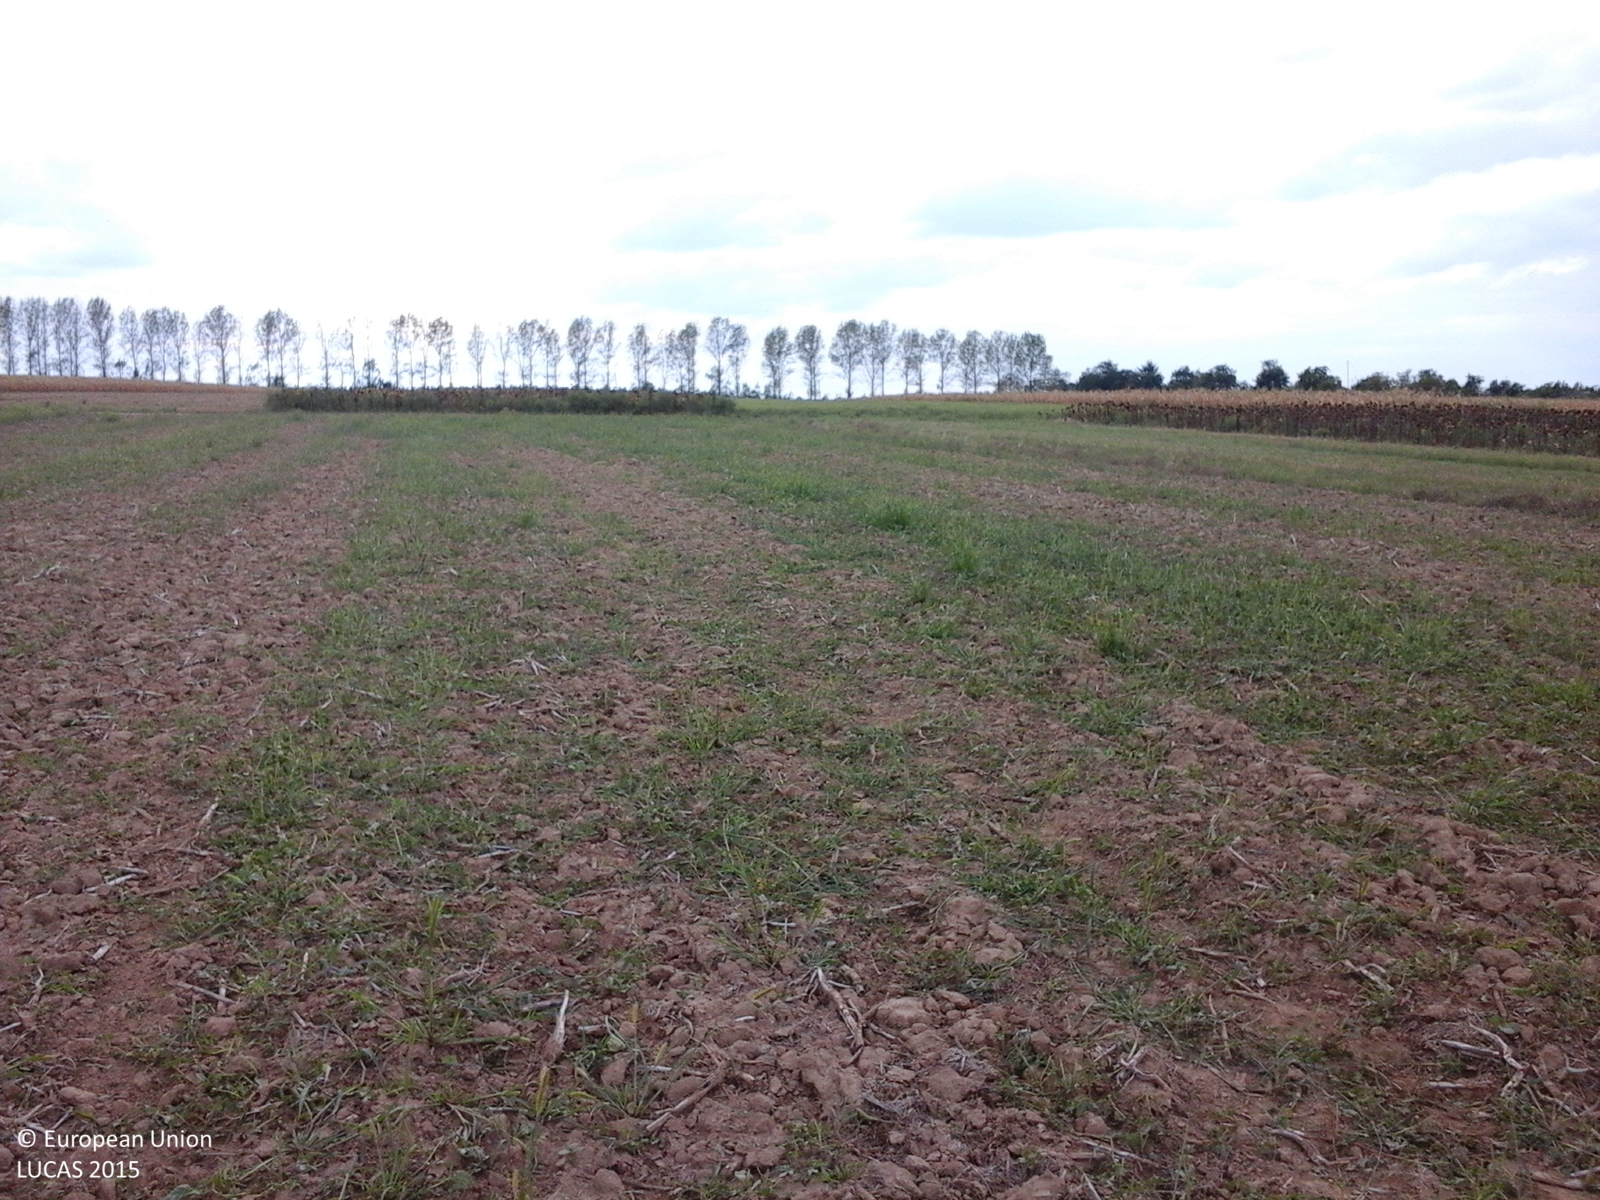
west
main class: Cropland
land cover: Rape and turnip rape
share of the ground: 10 - 25 %
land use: Agriculture (excluding fallow land and kitchen gardens)
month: September
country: RO
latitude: 47.4938
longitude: 22.6291
